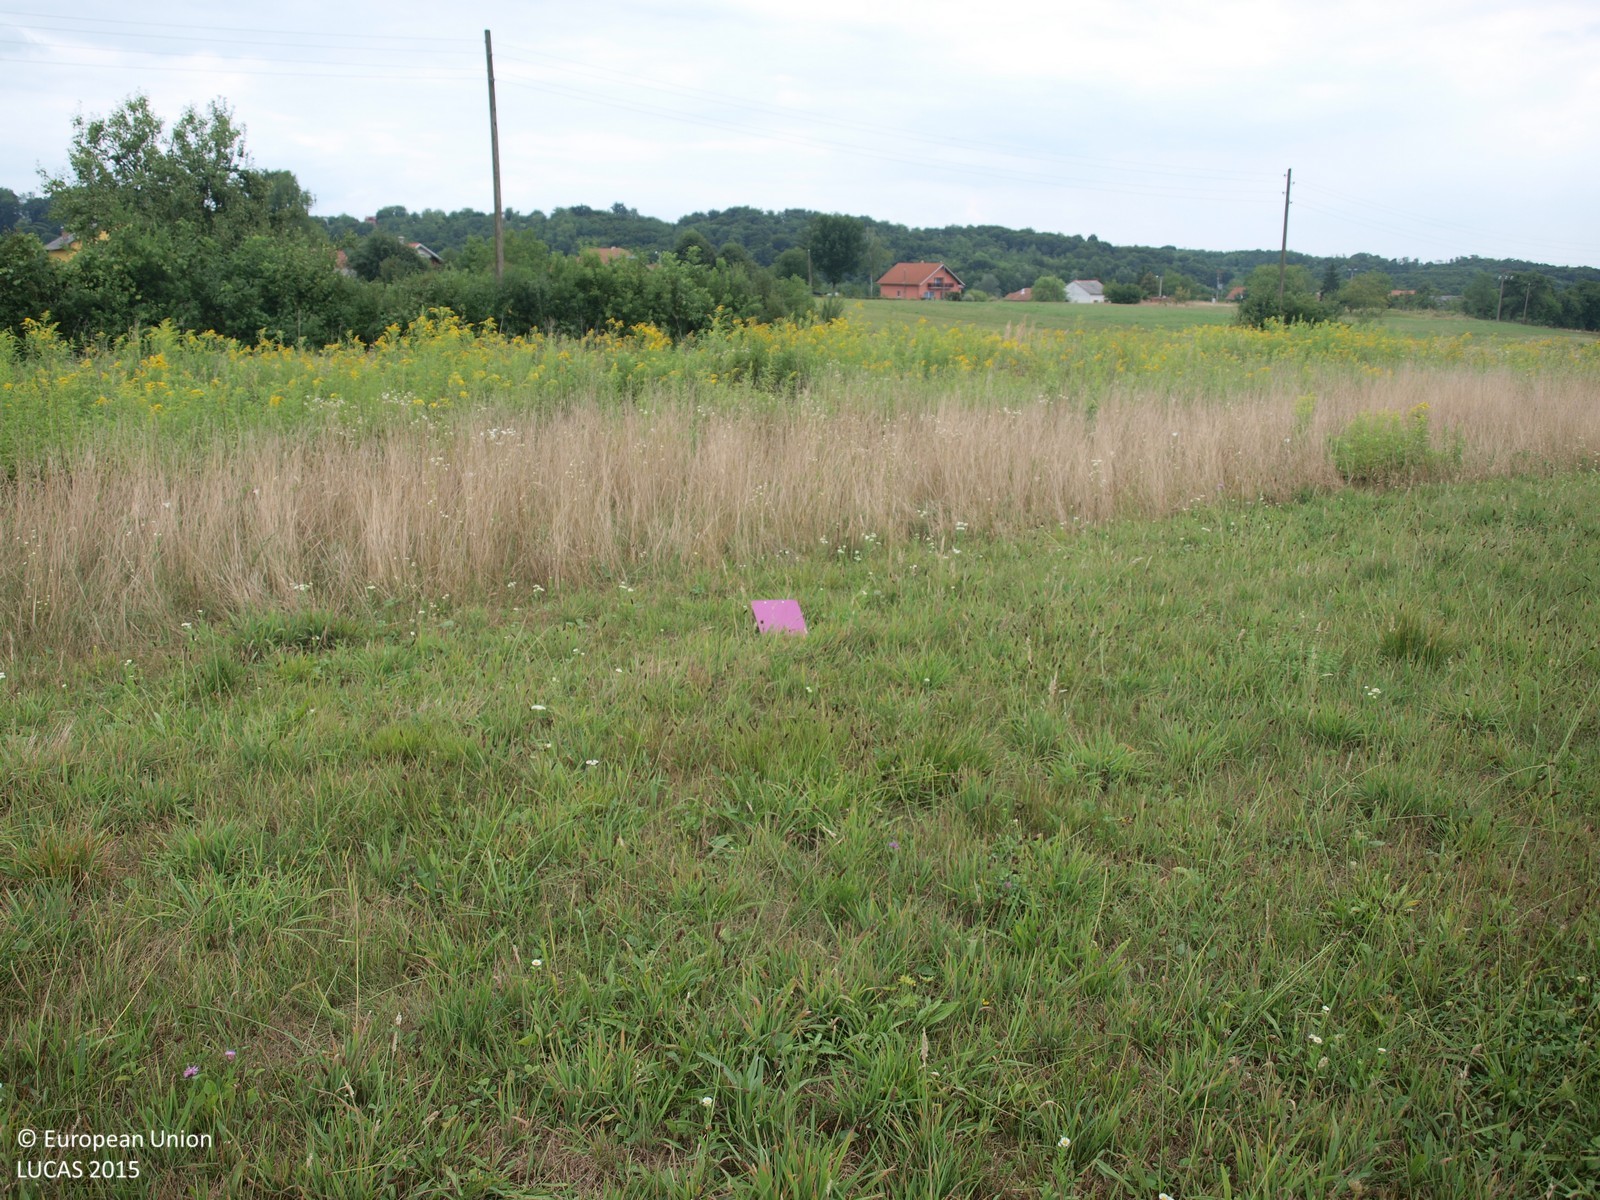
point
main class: Grassland
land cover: Grassland without tree/shrub cover
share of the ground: > 75 %
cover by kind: herbaceous plants 100 %
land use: Agriculture (excluding fallow land and kitchen gardens)
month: August
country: HR
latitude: 45.9467
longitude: 16.3330
